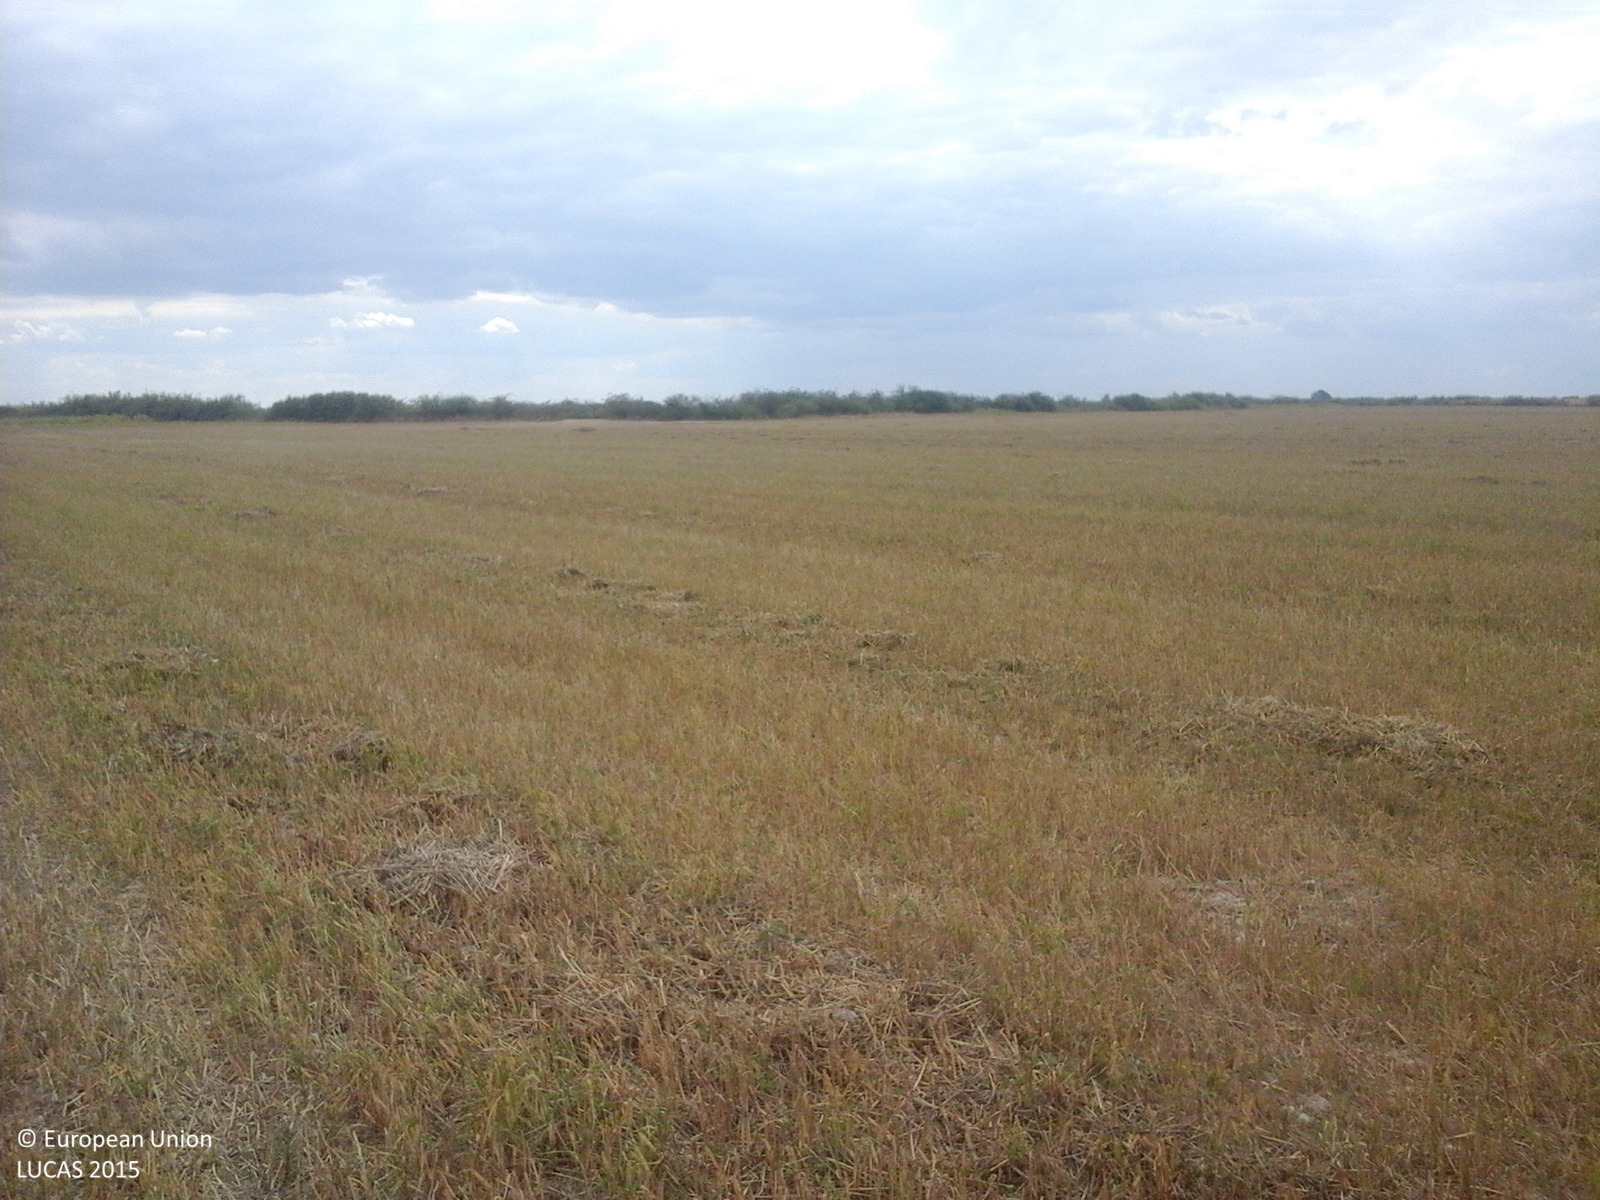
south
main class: Cropland
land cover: Common wheat
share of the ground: > 75 %
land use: Agriculture (excluding fallow land and kitchen gardens)
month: September
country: RO
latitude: 47.9061
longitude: 22.8409
